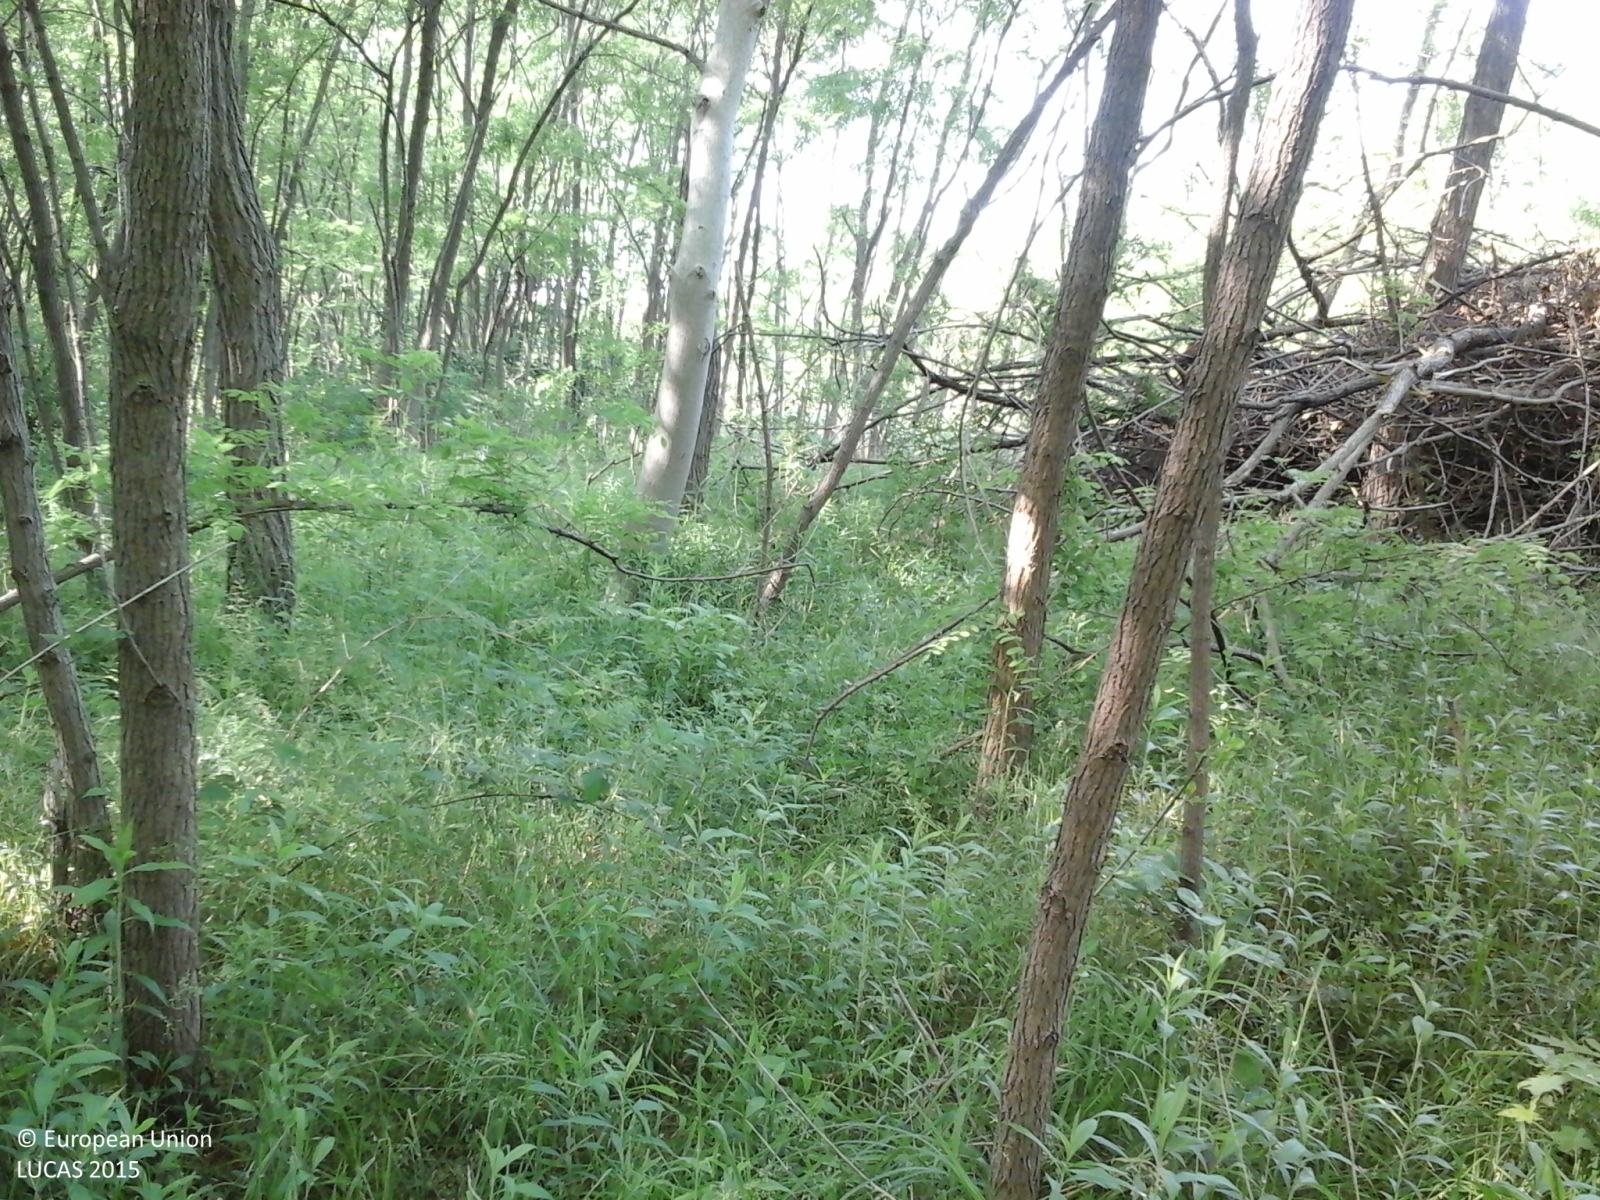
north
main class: Woodland
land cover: Broadleaved woodland
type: mesophytic deciduous forest
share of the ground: > 75 %
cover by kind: broadleaved forest trees 100 %
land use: Forestry
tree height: > 5 m
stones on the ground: < 10 %
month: May
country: IT
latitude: 45.5820
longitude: 8.3749
